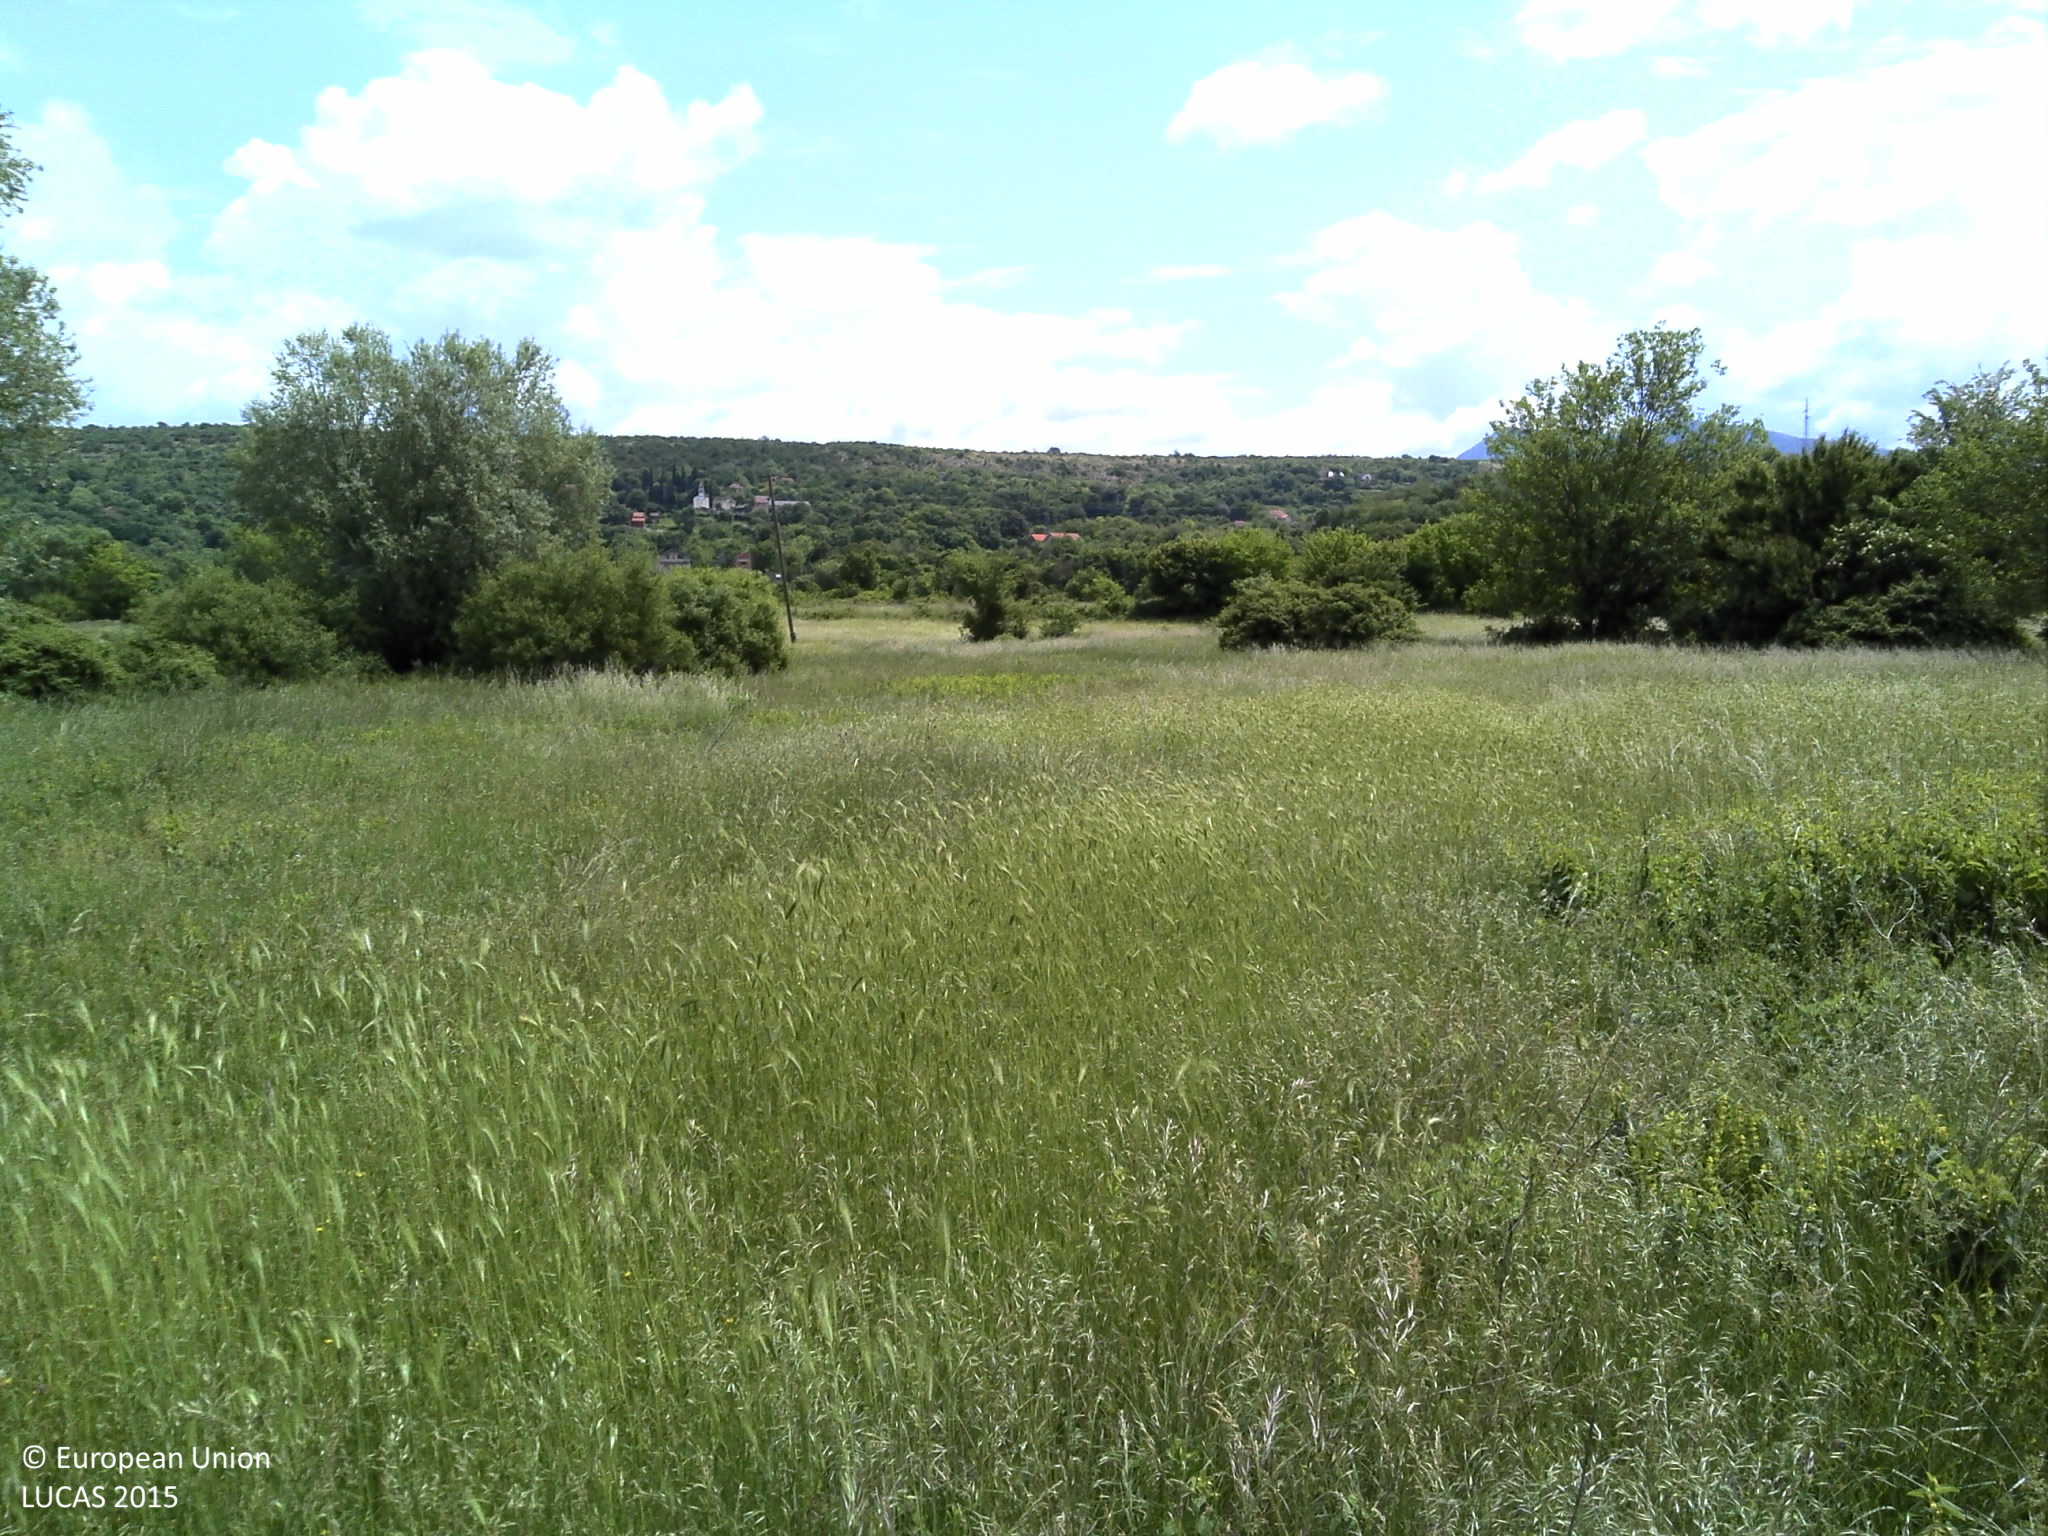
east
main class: Grassland
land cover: Grassland without tree/shrub cover
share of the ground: > 75 %
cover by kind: herbaceous plants 100 %
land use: Abandoned areas
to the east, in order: Grassland without tree/shrub cover; Grassland with sparse tree/shrub cover; Paved roads, cycling and walking lanes; Grassland without tree/shrub cover; Electric lines; Grassland without tree/shrub cover; Paved roads, cycling and walking lanes; Grassland with sparse tree/shrub cover; Grassland without tree/shrub cover; Paved roads, cycling and walking lanes; Grassland with sparse tree/shrub cover; Grassland without tree/shrub cover
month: May
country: HR
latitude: 44.0014
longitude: 16.2155
